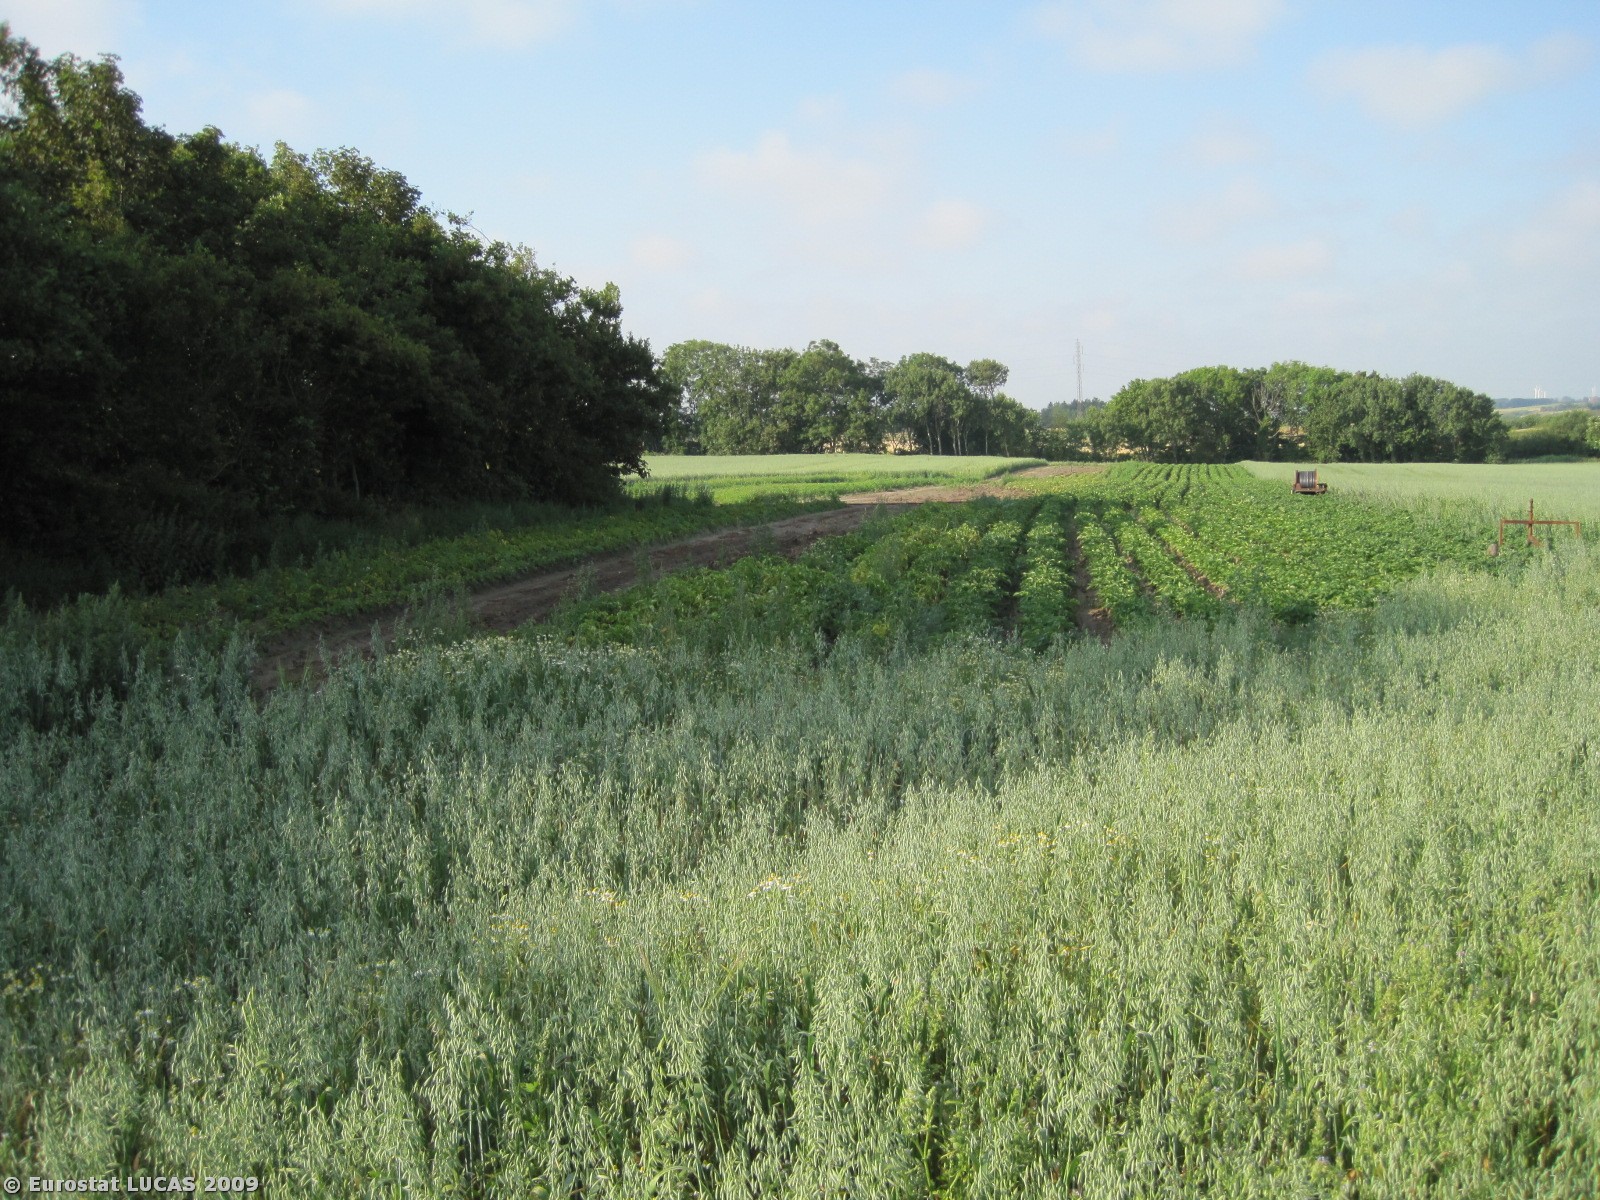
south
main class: Grassland
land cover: Grassland without tree/shrub cover
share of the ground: > 75 %
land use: Unused
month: July
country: DK
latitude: 56.4514
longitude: 8.7523
